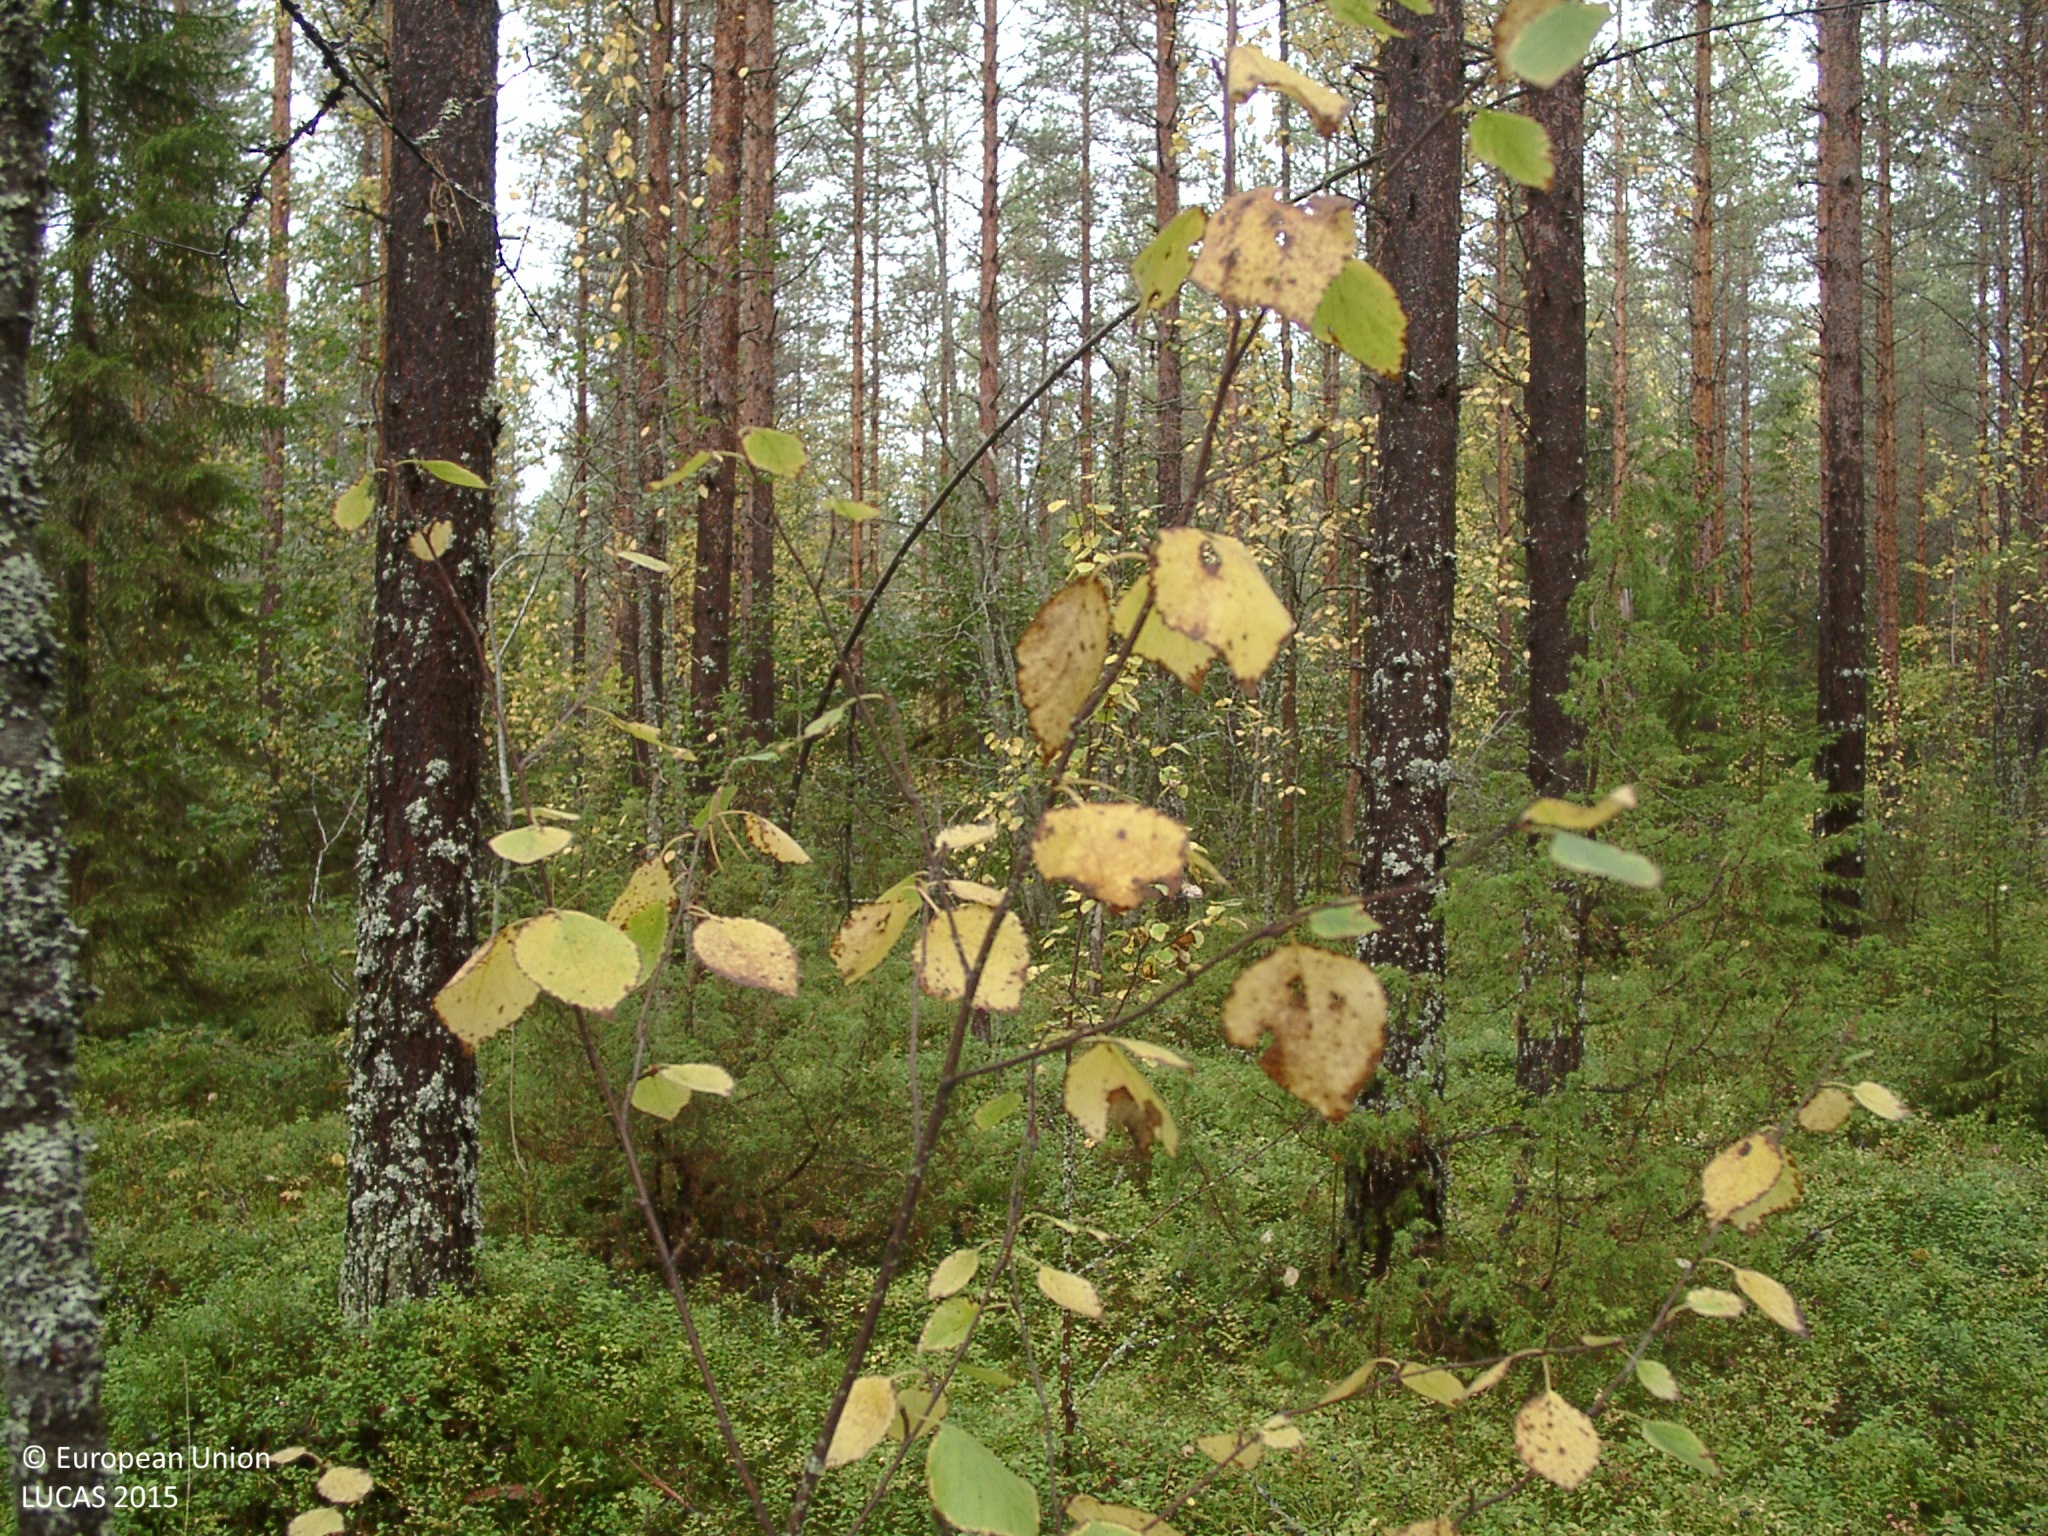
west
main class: Woodland
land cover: Pine dominated coniferous woodland
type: boreal forest
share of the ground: 50 - 75 %
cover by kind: coniferous forest trees 65 %, shrubs 30 %, broadleaved forest trees 5 %
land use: Forestry
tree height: > 5 m
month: September
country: FI
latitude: 62.4987
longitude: 25.1874
